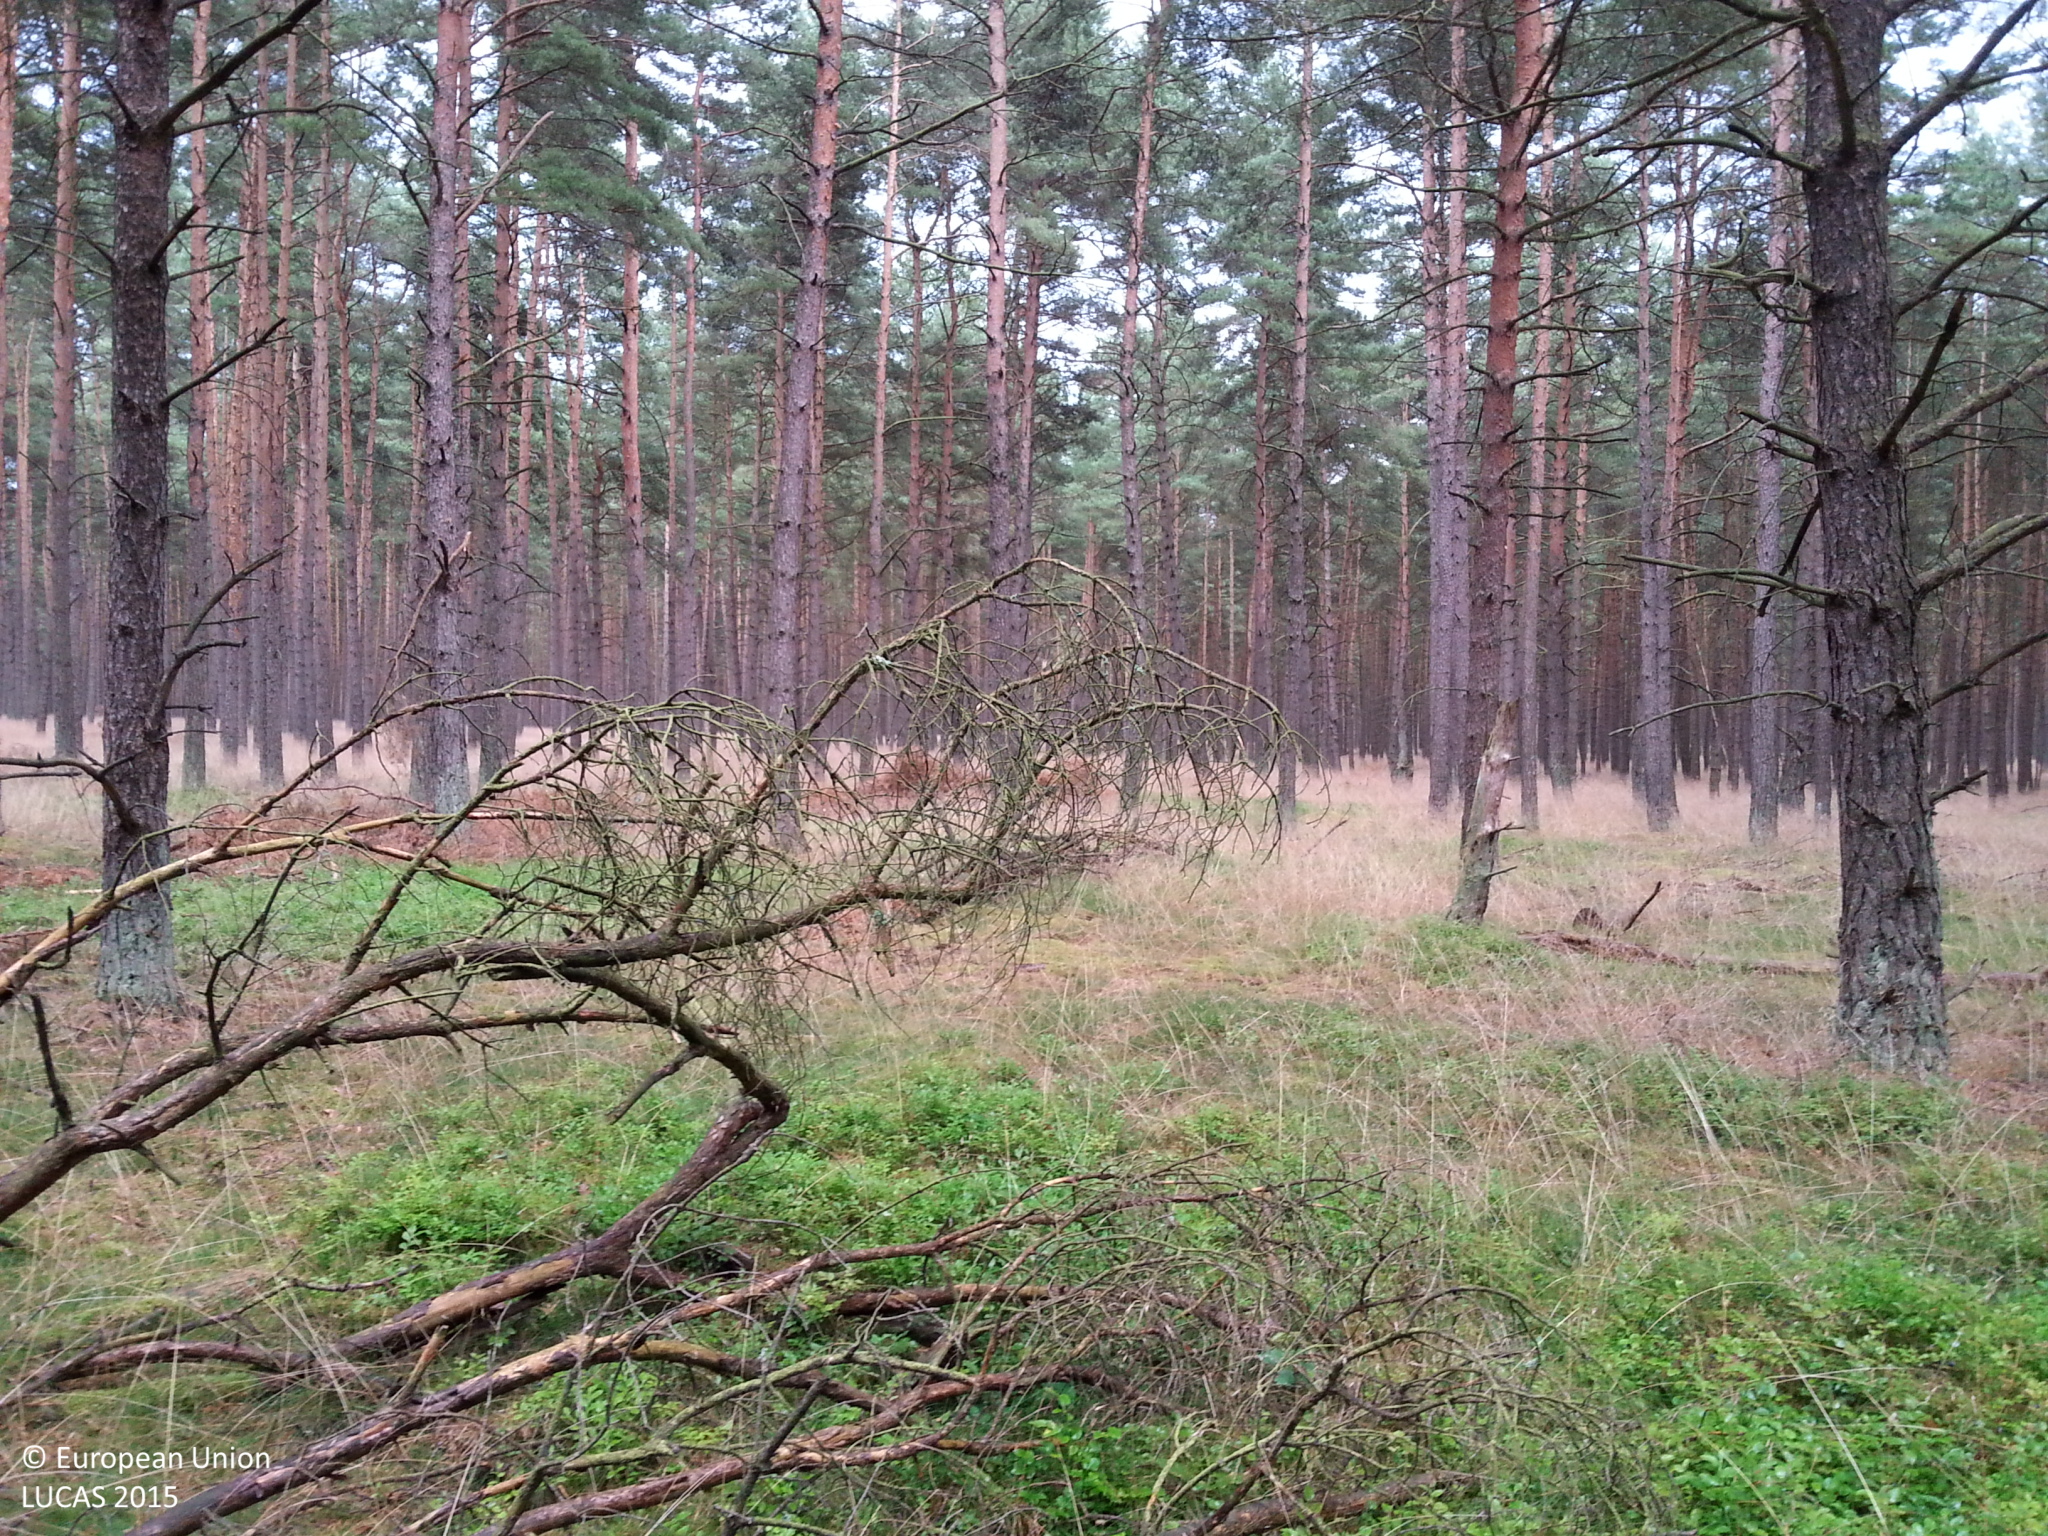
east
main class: Woodland
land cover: Pine dominated coniferous woodland
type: hemiboreal forest and nemoral coniferous forest and mixed broadleaved-coniferous forest
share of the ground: 50 - 75 %
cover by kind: coniferous forest trees 50 %, herbaceous plants 35 %, lichens and mosses 15 %
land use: Forestry
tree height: > 5 m
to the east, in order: Pine dominated coniferous woodland
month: July
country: DE
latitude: 53.1095
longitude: 12.3447
